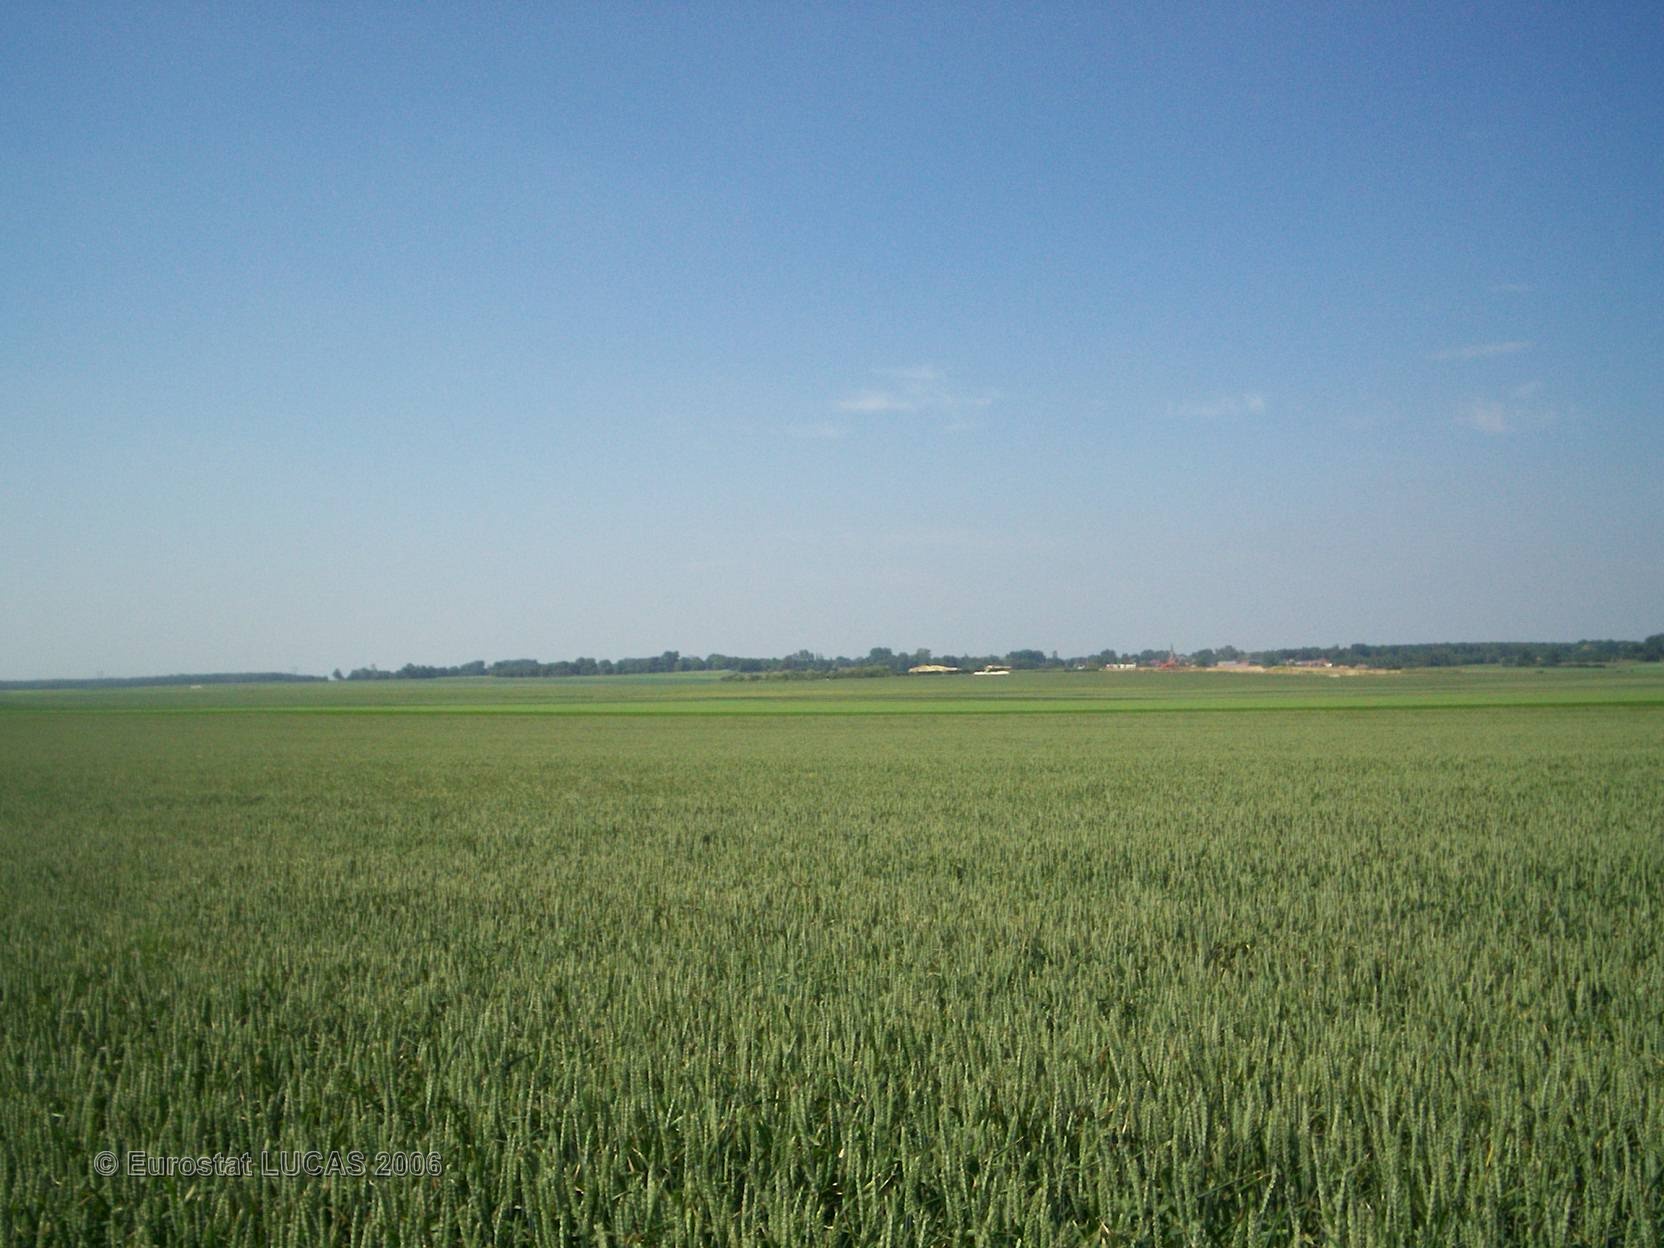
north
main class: Cropland
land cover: Common wheat
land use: Agriculture (excluding fallow land and kitchen gardens)
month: June
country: FR
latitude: 49.5674
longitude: 2.6466
